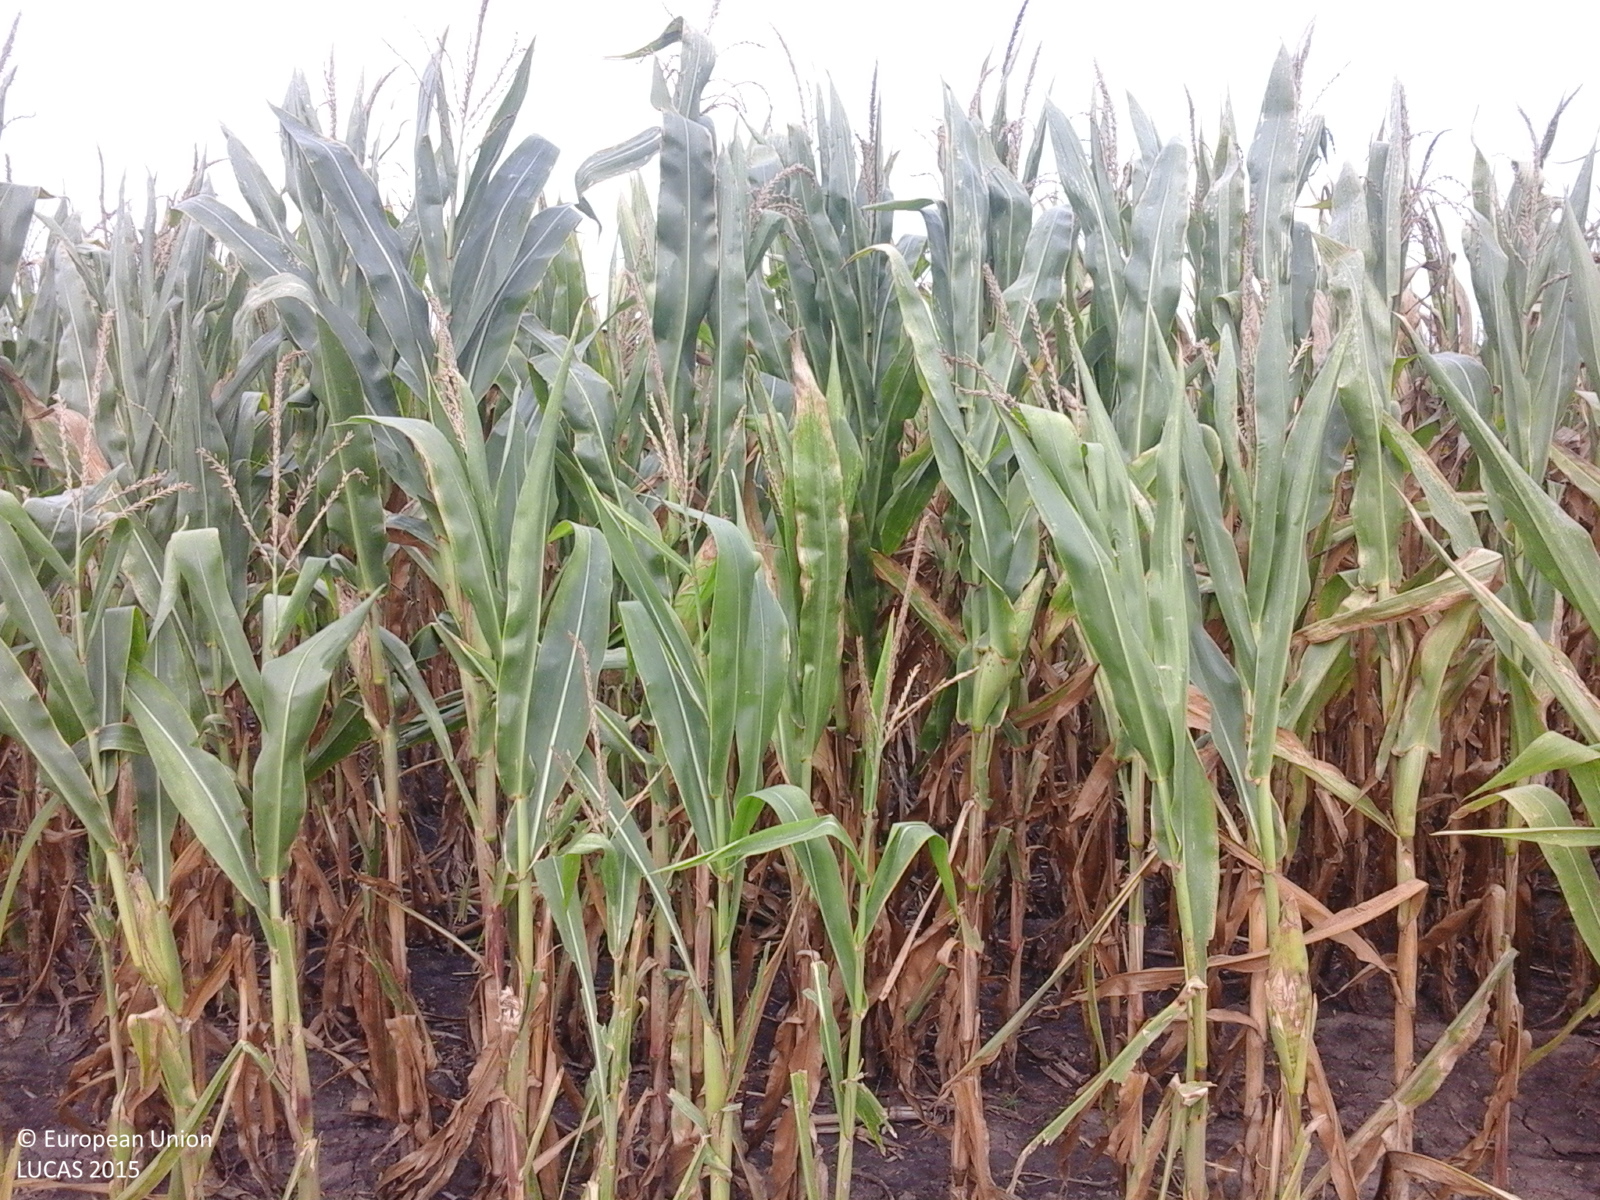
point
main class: Cropland
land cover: Maize
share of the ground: > 75 %
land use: Agriculture (excluding fallow land and kitchen gardens)
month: August
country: RO
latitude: 46.2516
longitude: 21.2013
